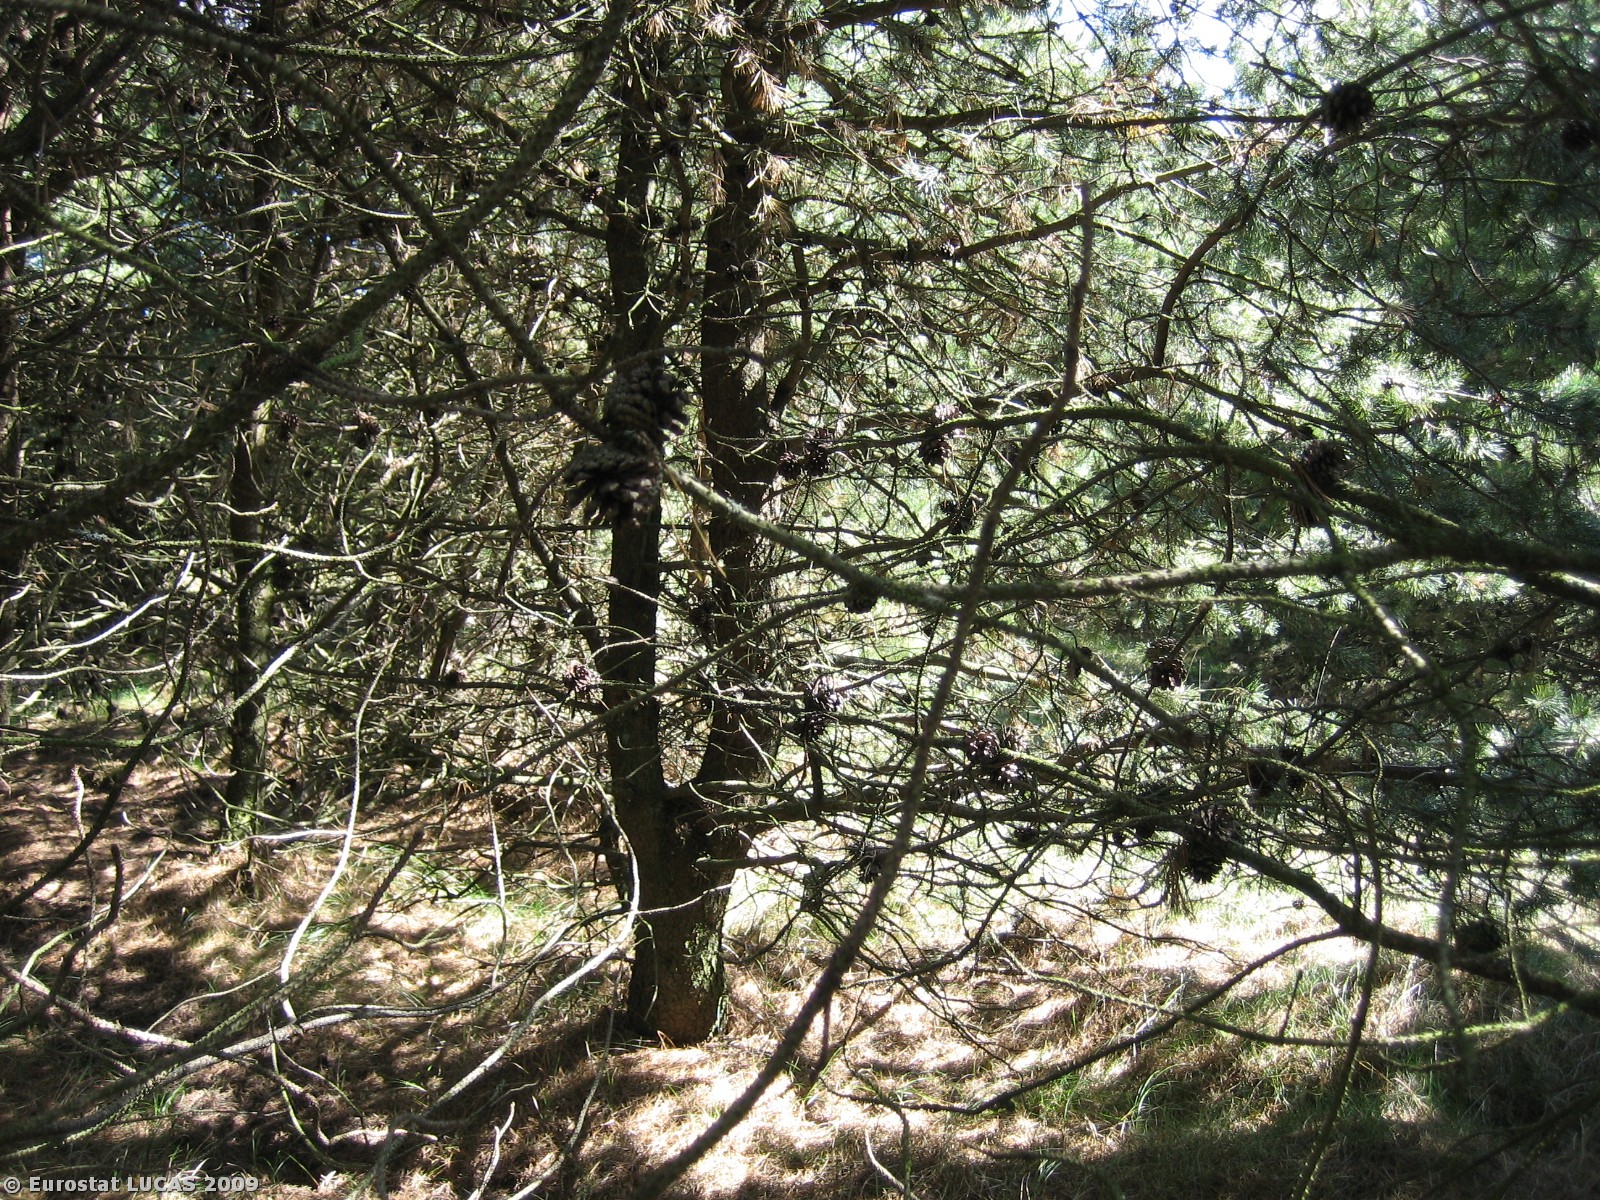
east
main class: Woodland
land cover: Coniferous woodland
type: hemiboreal forest and nemoral coniferous forest and mixed broadleaved-coniferous forest
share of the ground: > 75 %
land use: Forestry
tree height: > 5 m
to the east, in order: Coniferous woodland; Grass margins; Coniferous woodland; Tracks; Coniferous woodland; Grass margins; Coniferous woodland; Grassland without tree/shrub cover; Fences; Coniferous woodland
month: May
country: DK
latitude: 56.2489
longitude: 8.3396
